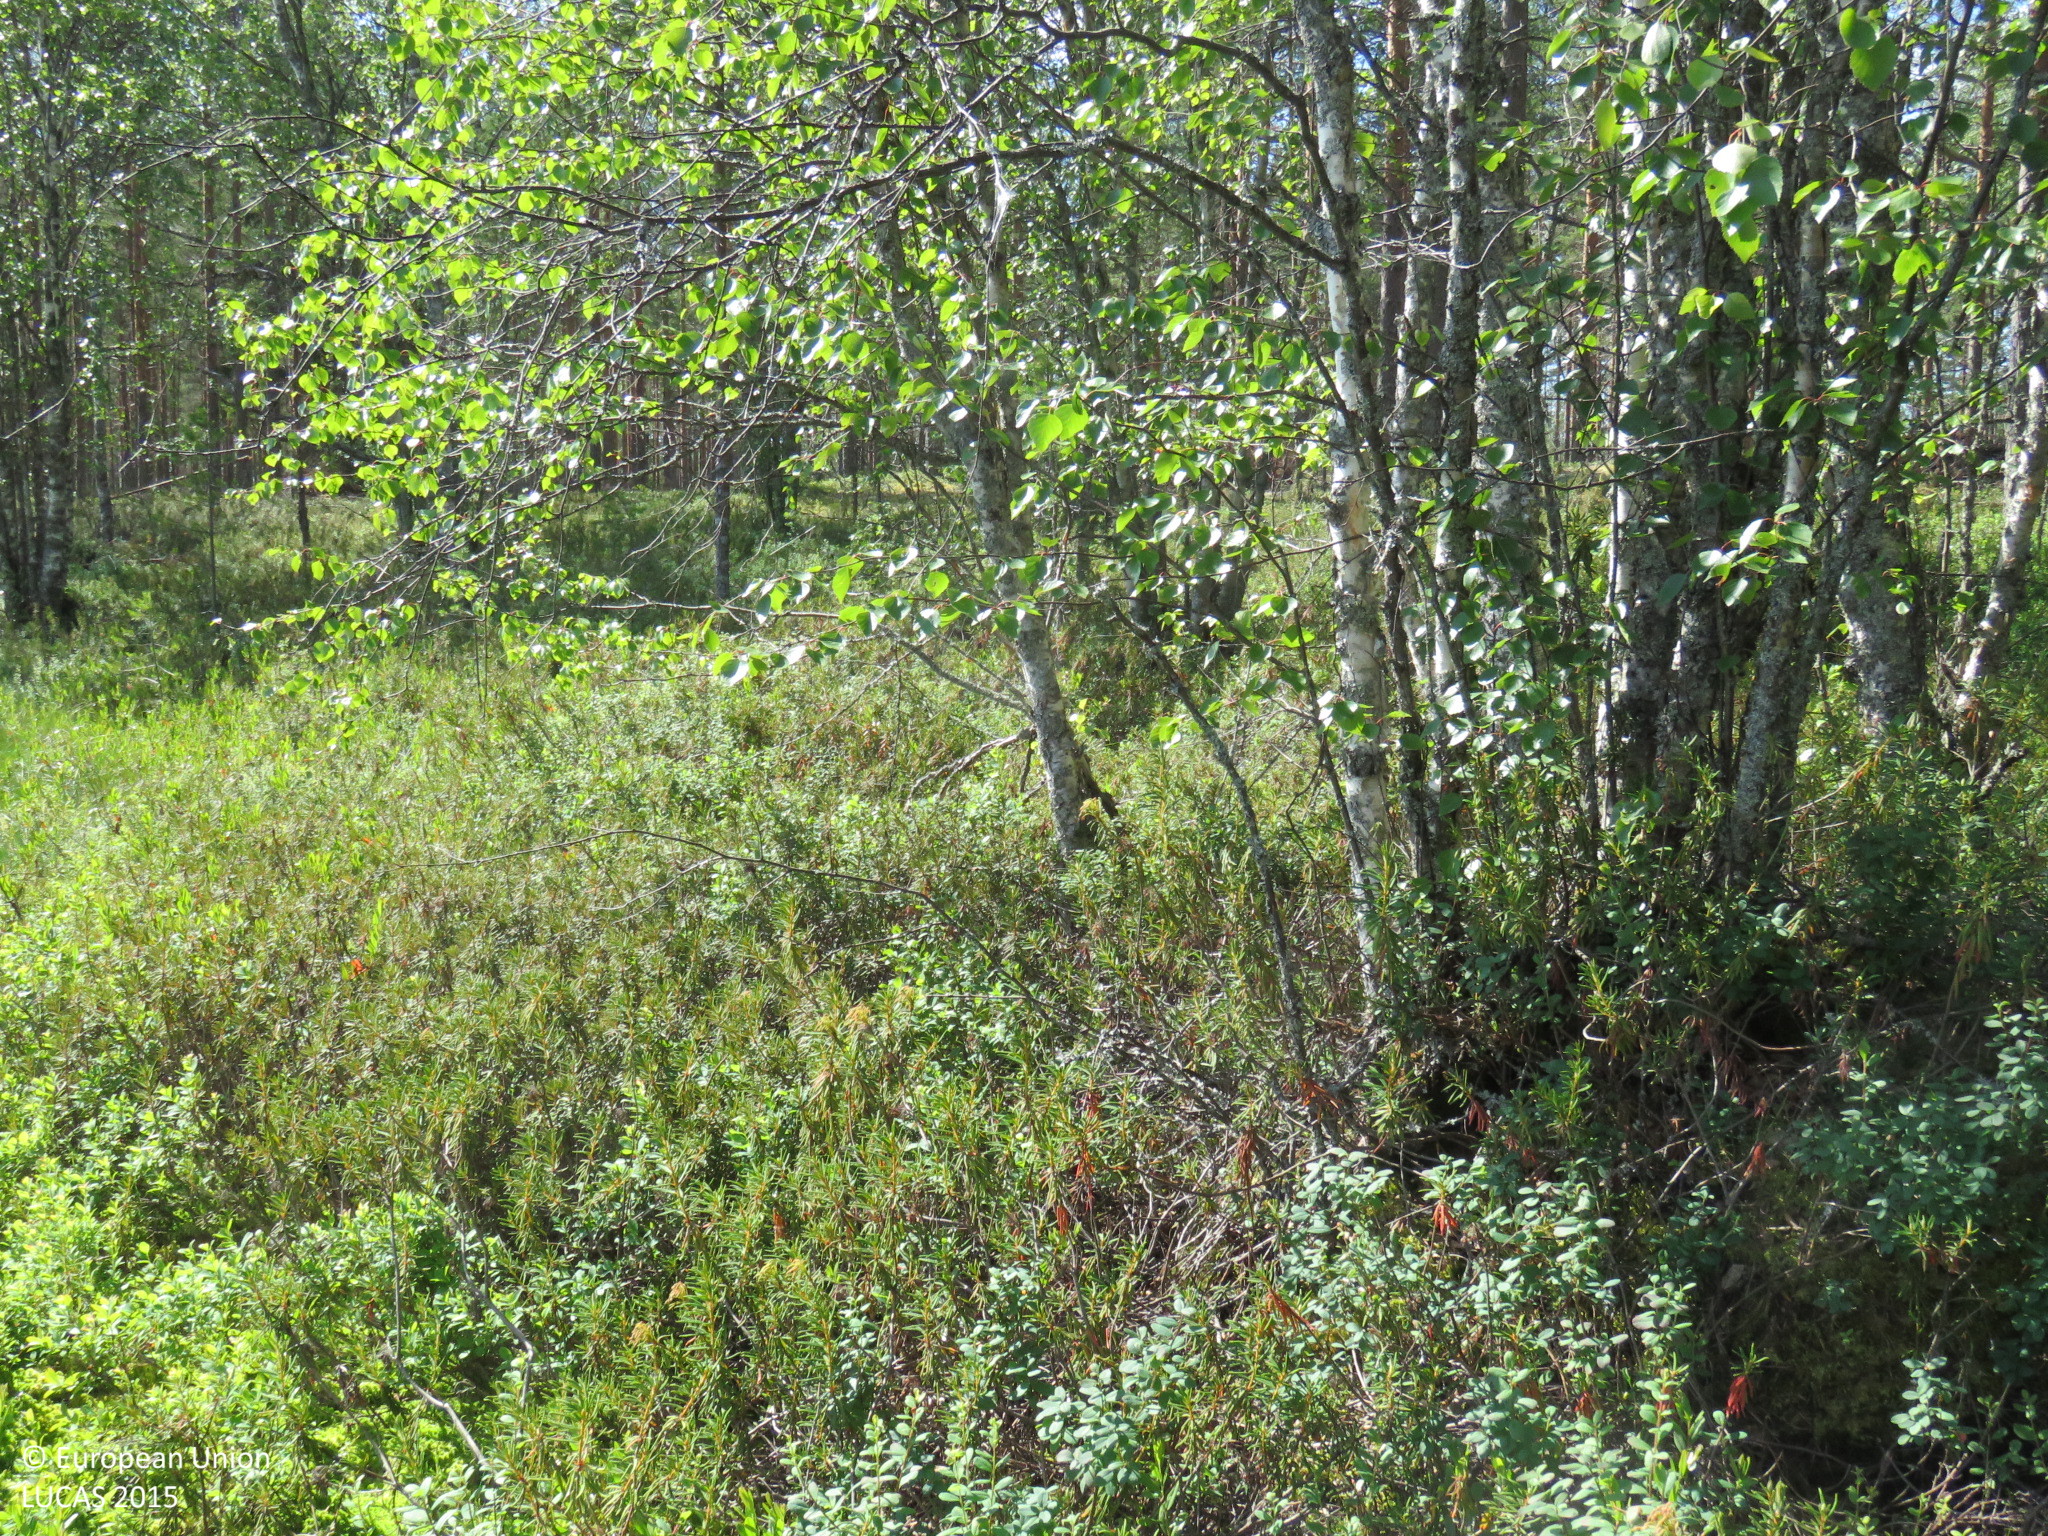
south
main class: Woodland
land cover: Pine dominated mixed woodland
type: boreal forest
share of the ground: > 75 %
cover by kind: coniferous forest trees 50 %, broadleaved forest trees 30 %, shrubs 20 %
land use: Forestry
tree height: > 5 m
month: July
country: FI
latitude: 64.6769
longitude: 26.3046
